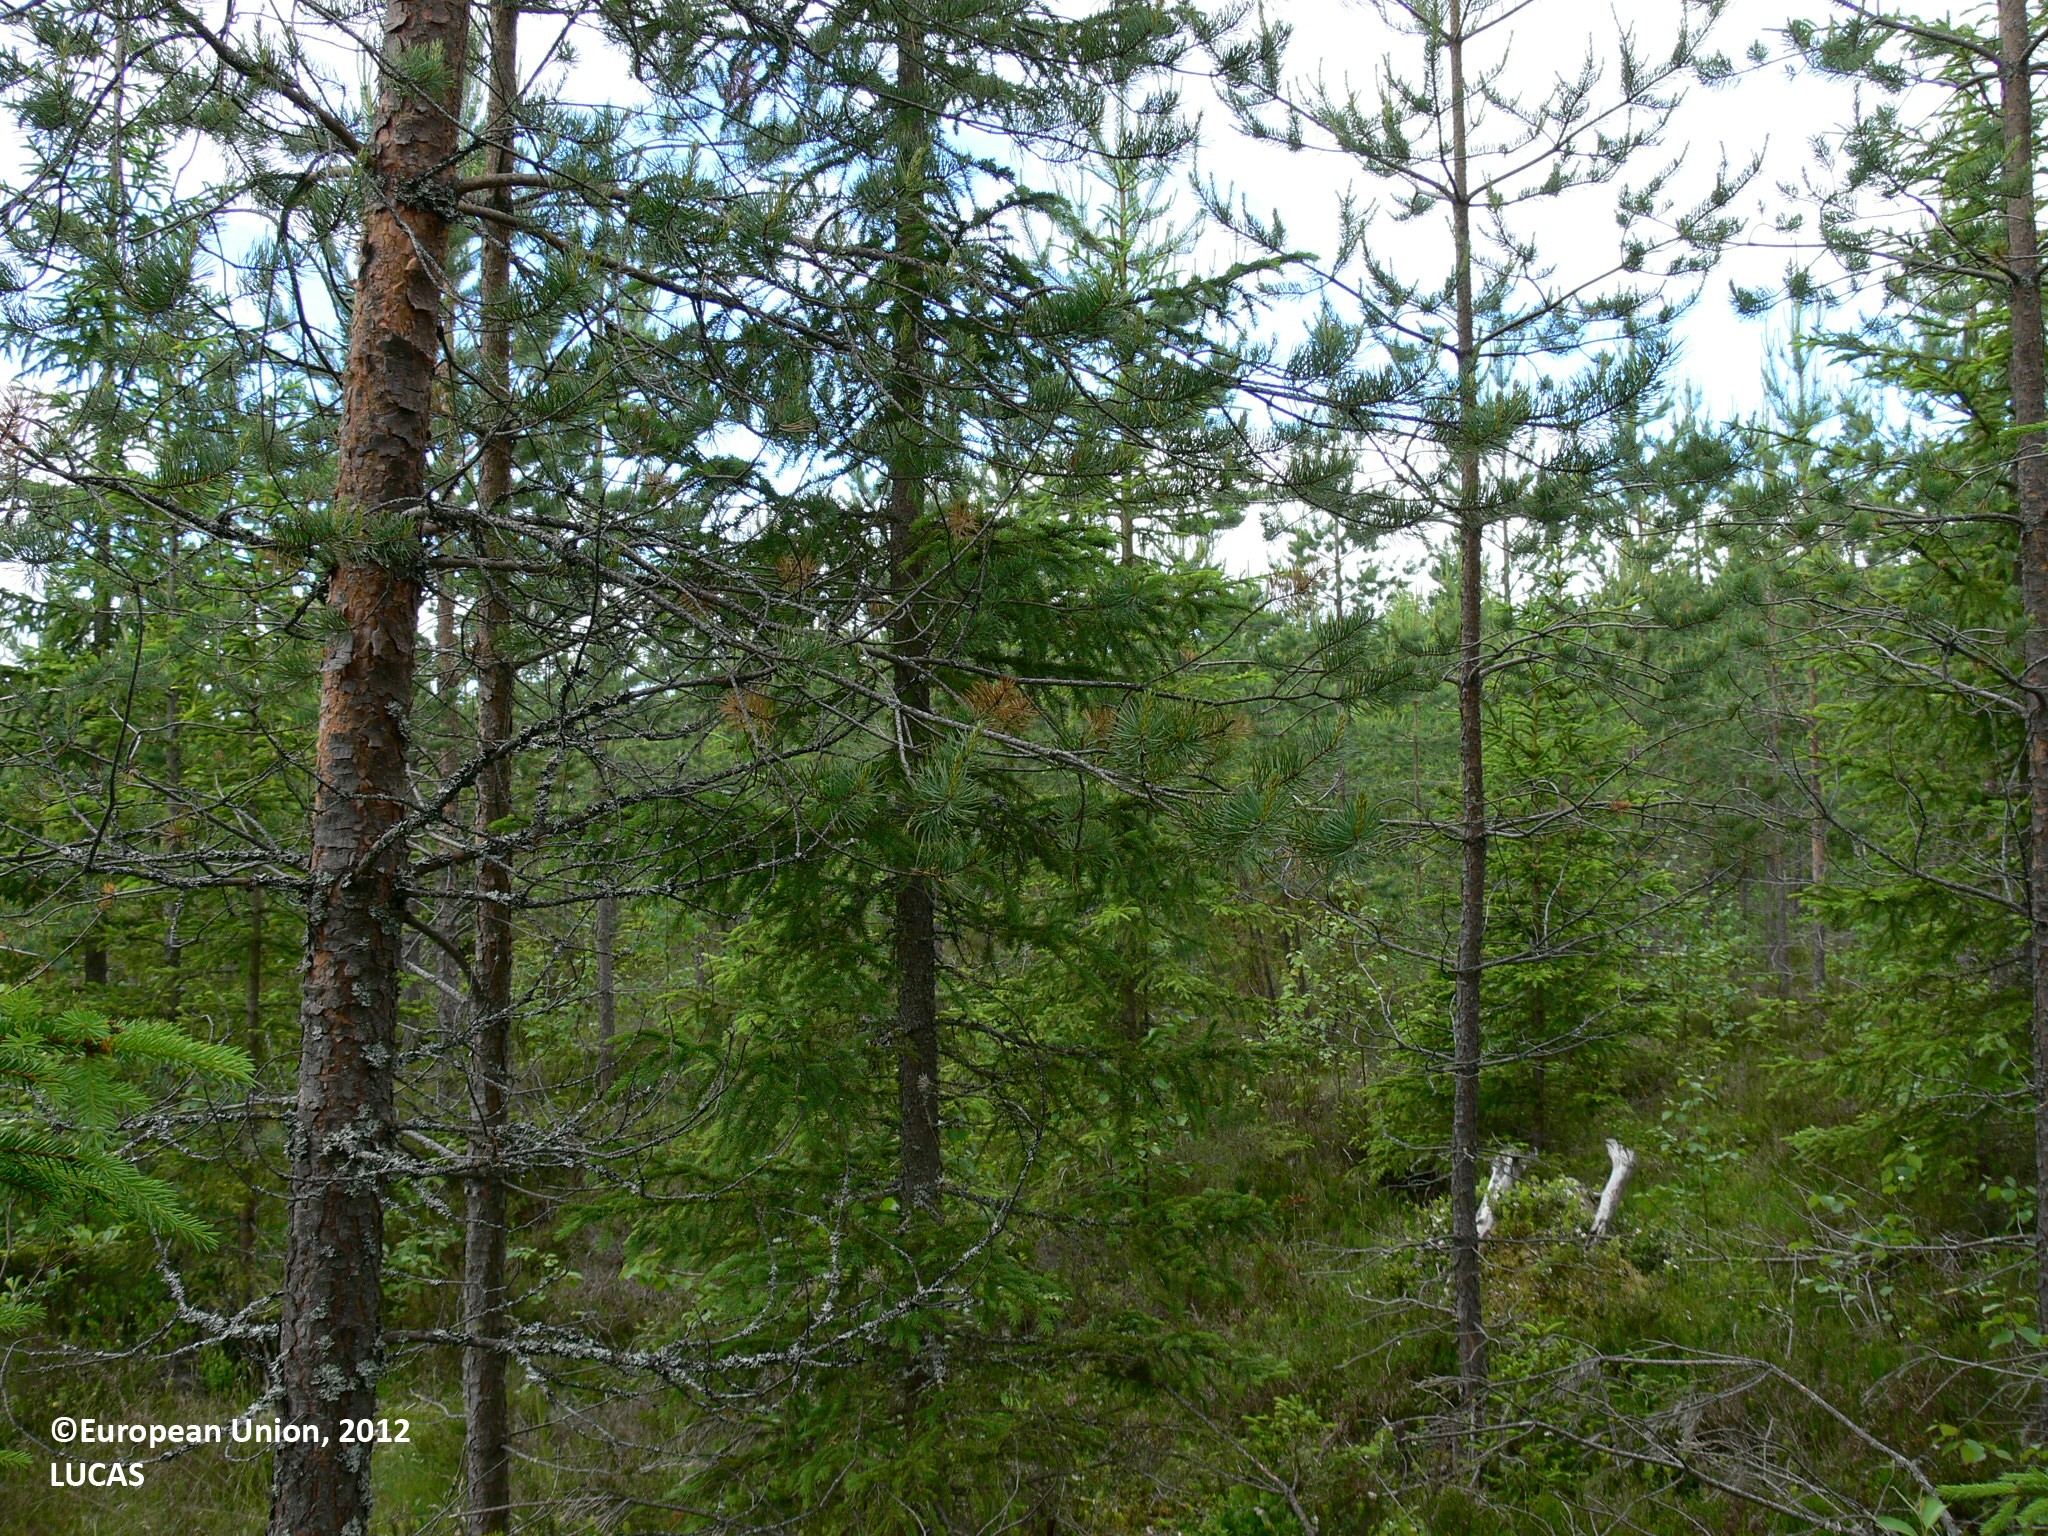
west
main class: Woodland
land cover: Other coniferous woodland
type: boreal forest
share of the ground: > 75 %
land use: Forestry
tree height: < 5 m
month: June
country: FI
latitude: 62.7302
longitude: 30.6522
